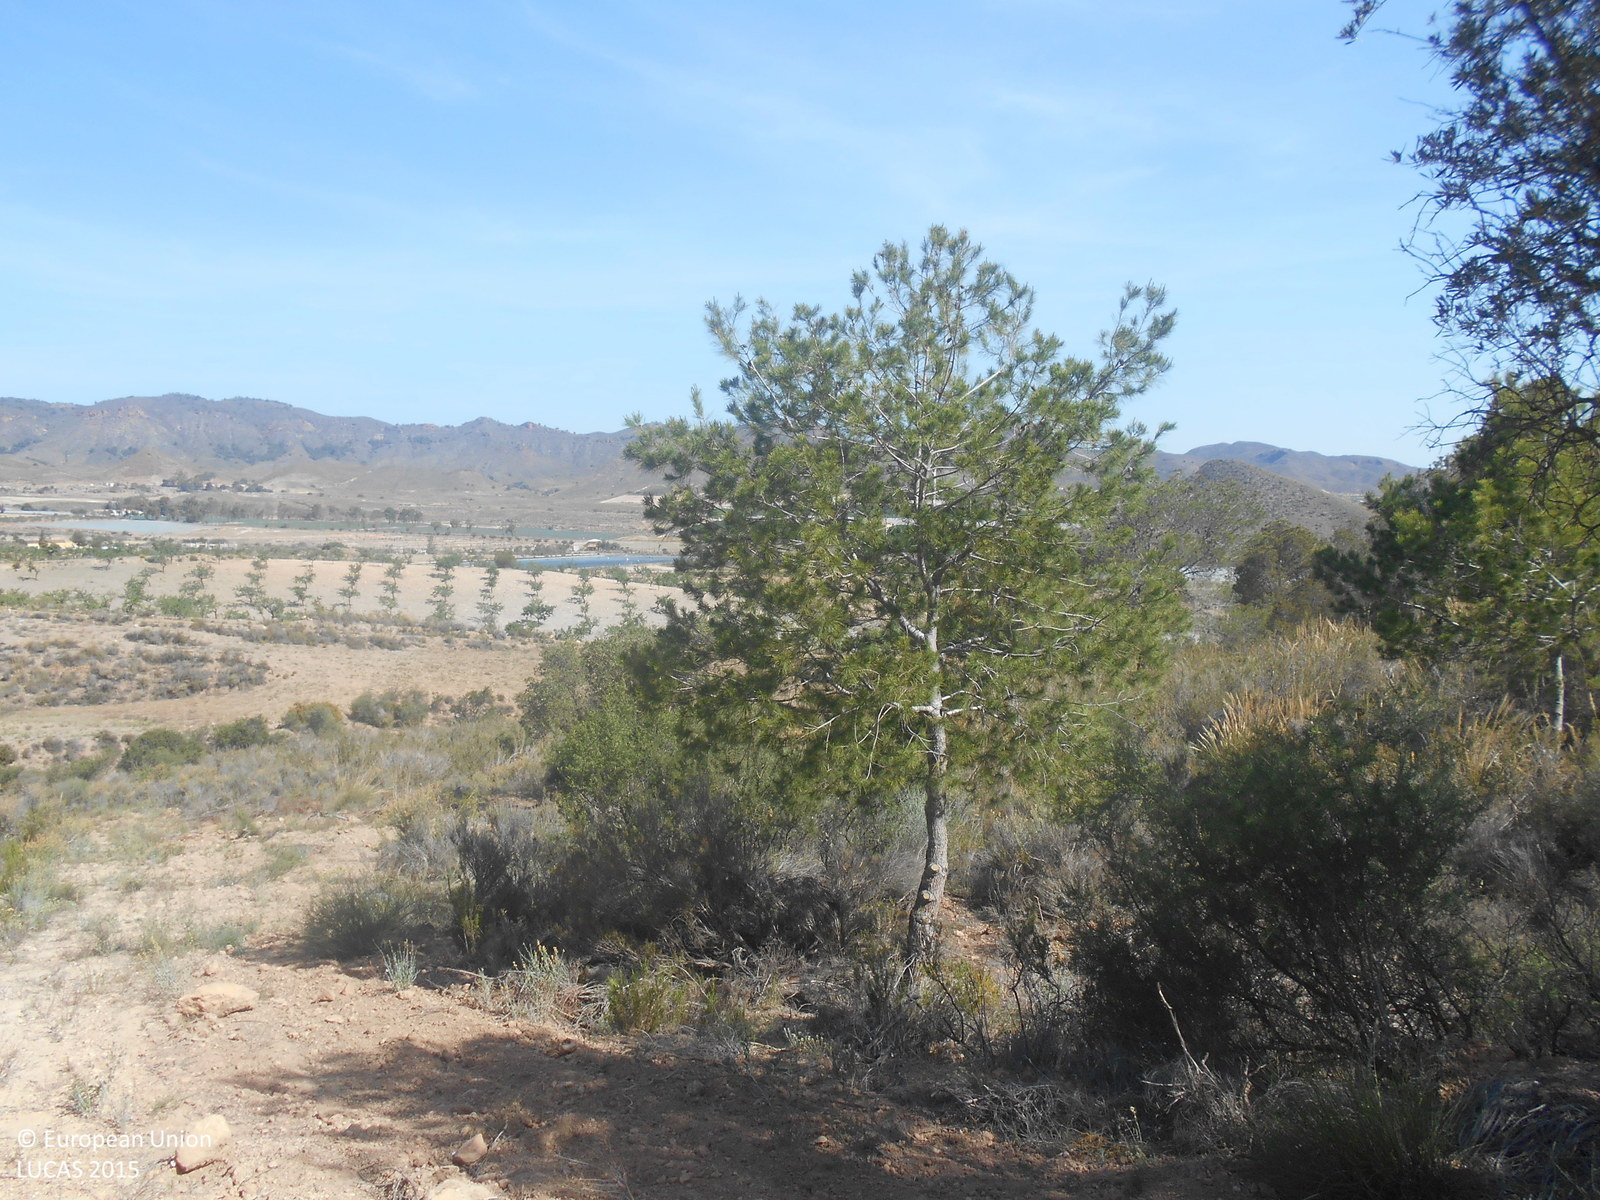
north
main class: Woodland
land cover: Pine dominated coniferous woodland
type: coniferous forest of the mediterranean region
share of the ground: 10 - 25 %
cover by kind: shrubs 60 %, coniferous forest trees 20 %, herbaceous plants 10 %, unconsolidated bare surface 10 %
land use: Semi-natural and natural areas not in use
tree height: > 5 m
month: May
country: ES
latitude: 37.6046
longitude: -1.4323
